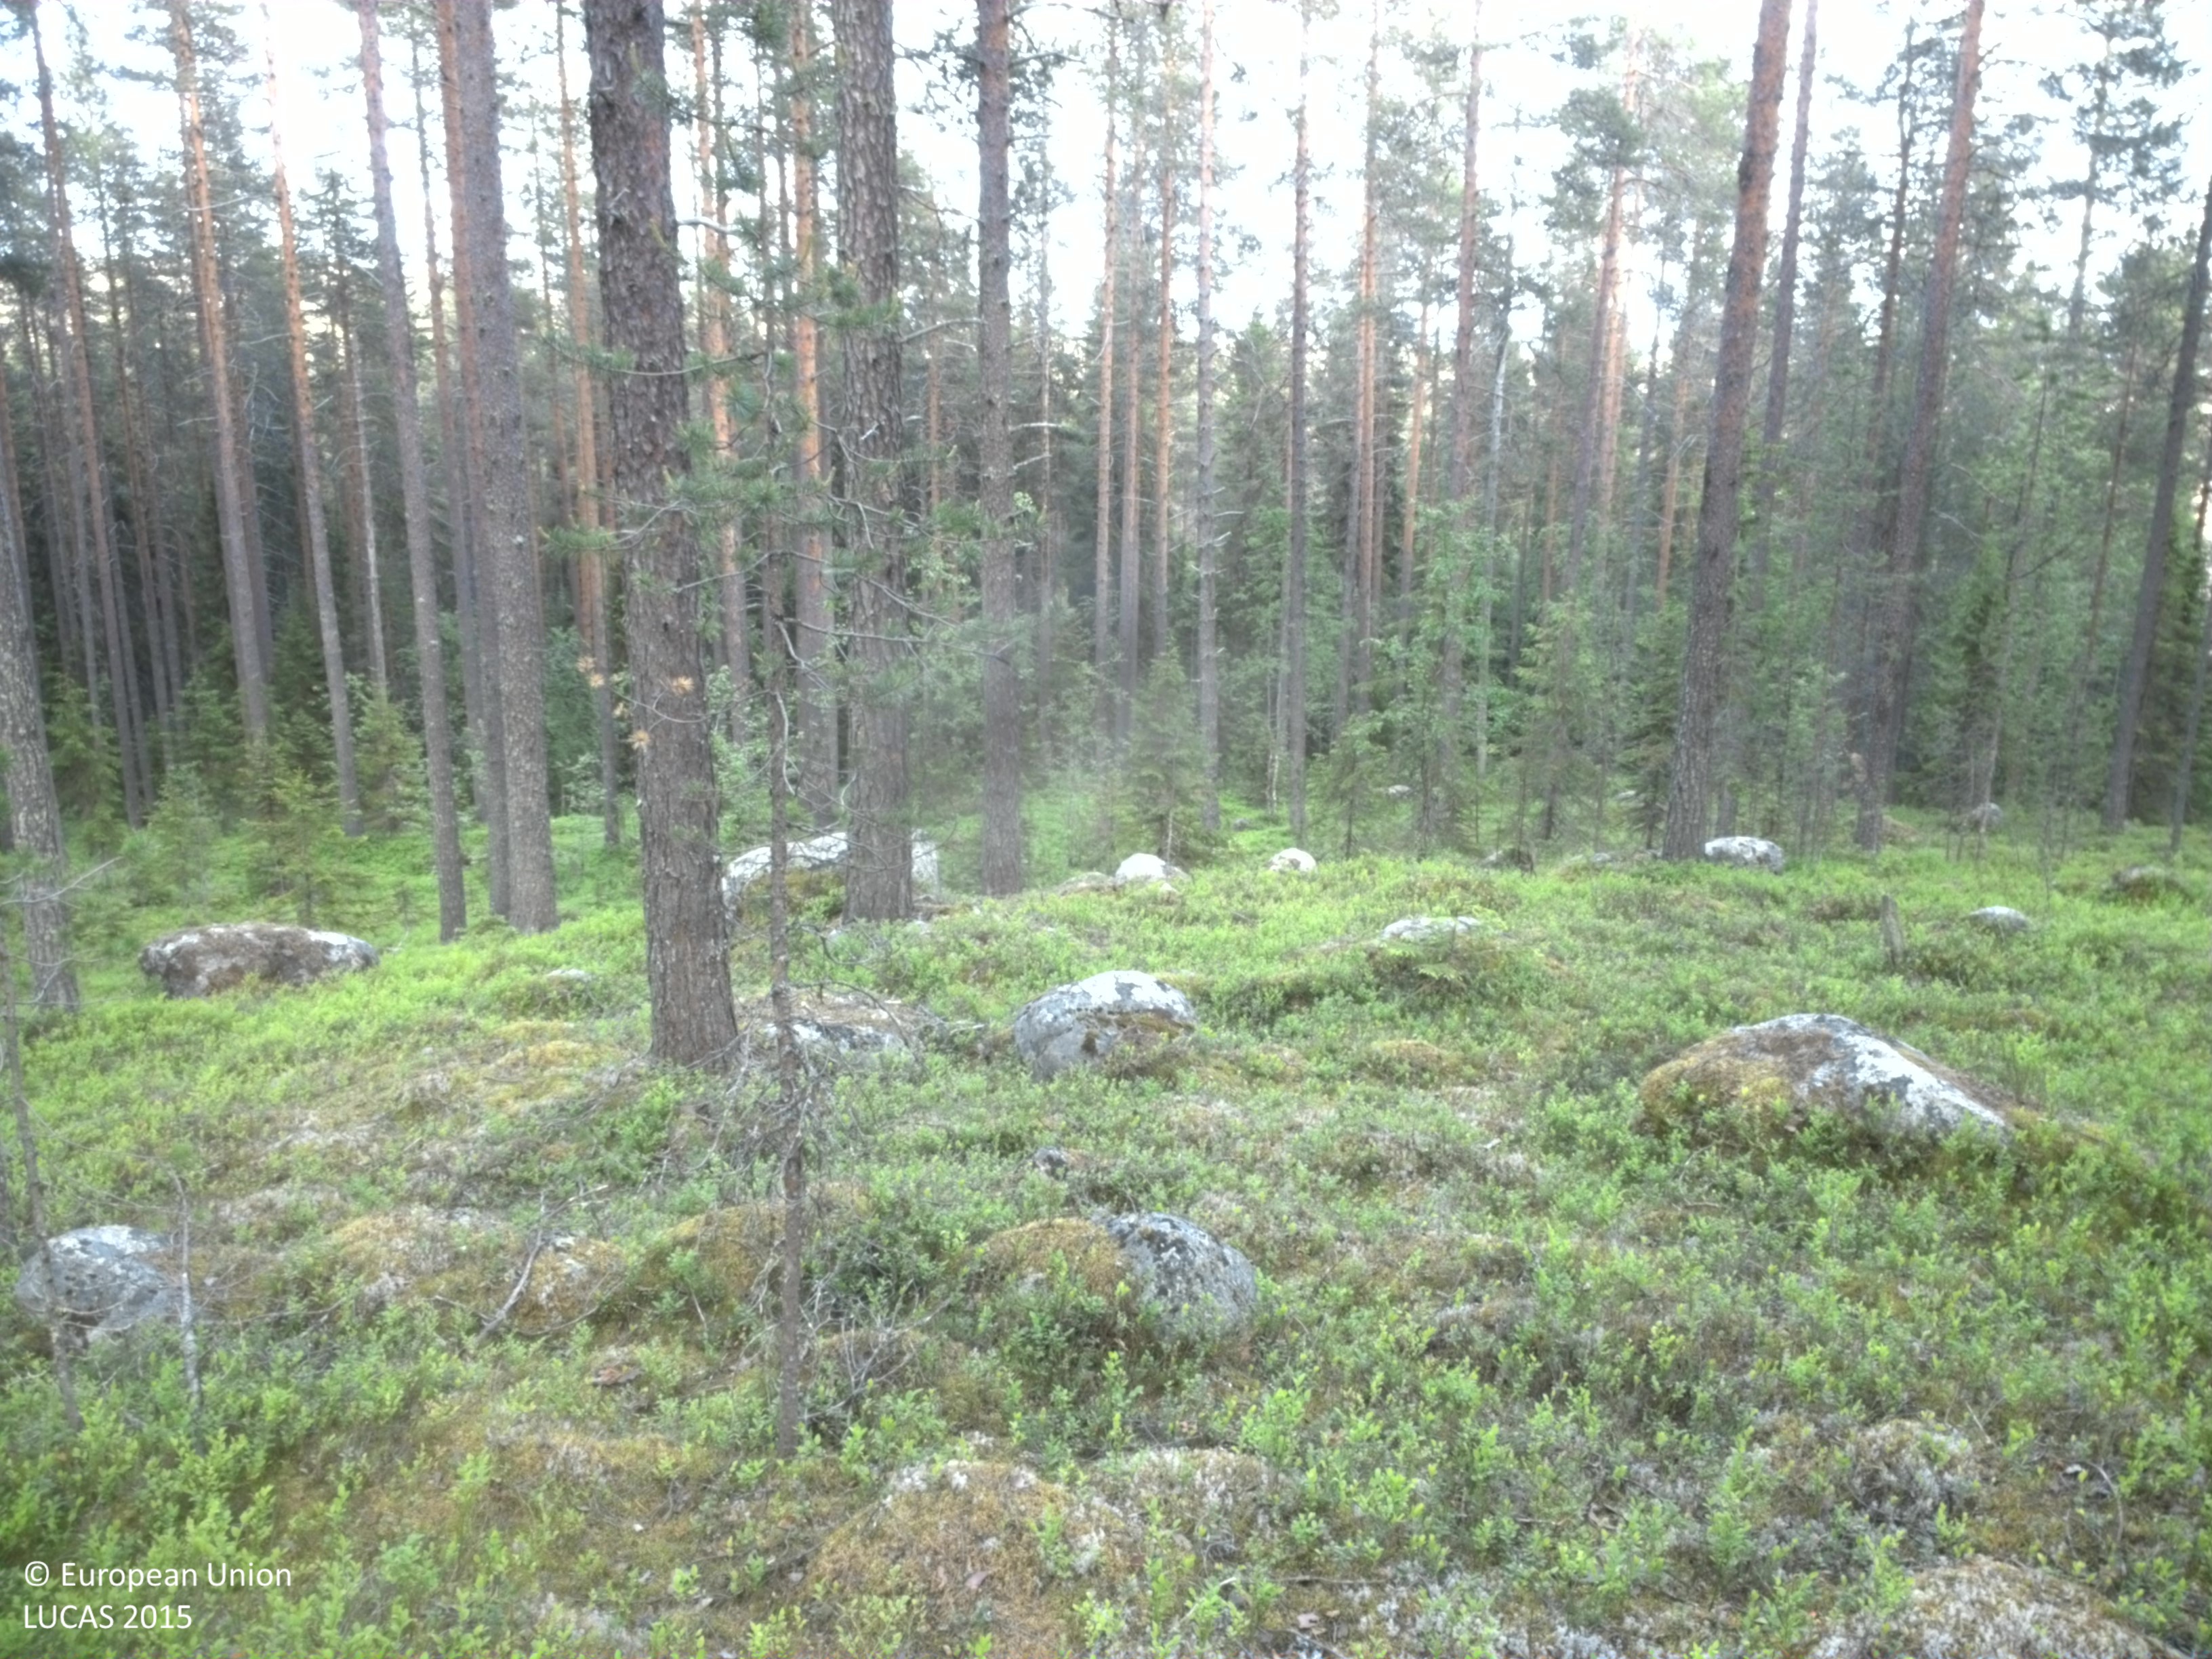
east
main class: Woodland
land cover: Pine dominated coniferous woodland
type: boreal forest
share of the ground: 25 - 50 %
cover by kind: shrubs 50 %, coniferous forest trees 40 %, consolidated bare surface 10 %
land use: Forestry
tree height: > 5 m
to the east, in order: Pine dominated coniferous woodland; Spruce dominated coniferous woodland; Pine dominated mixed woodland; Pine dominated coniferous woodland; Broadleaved woodland; Tracks; Pine dominated mixed woodland
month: June
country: SE
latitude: 66.3019
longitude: 22.7985
